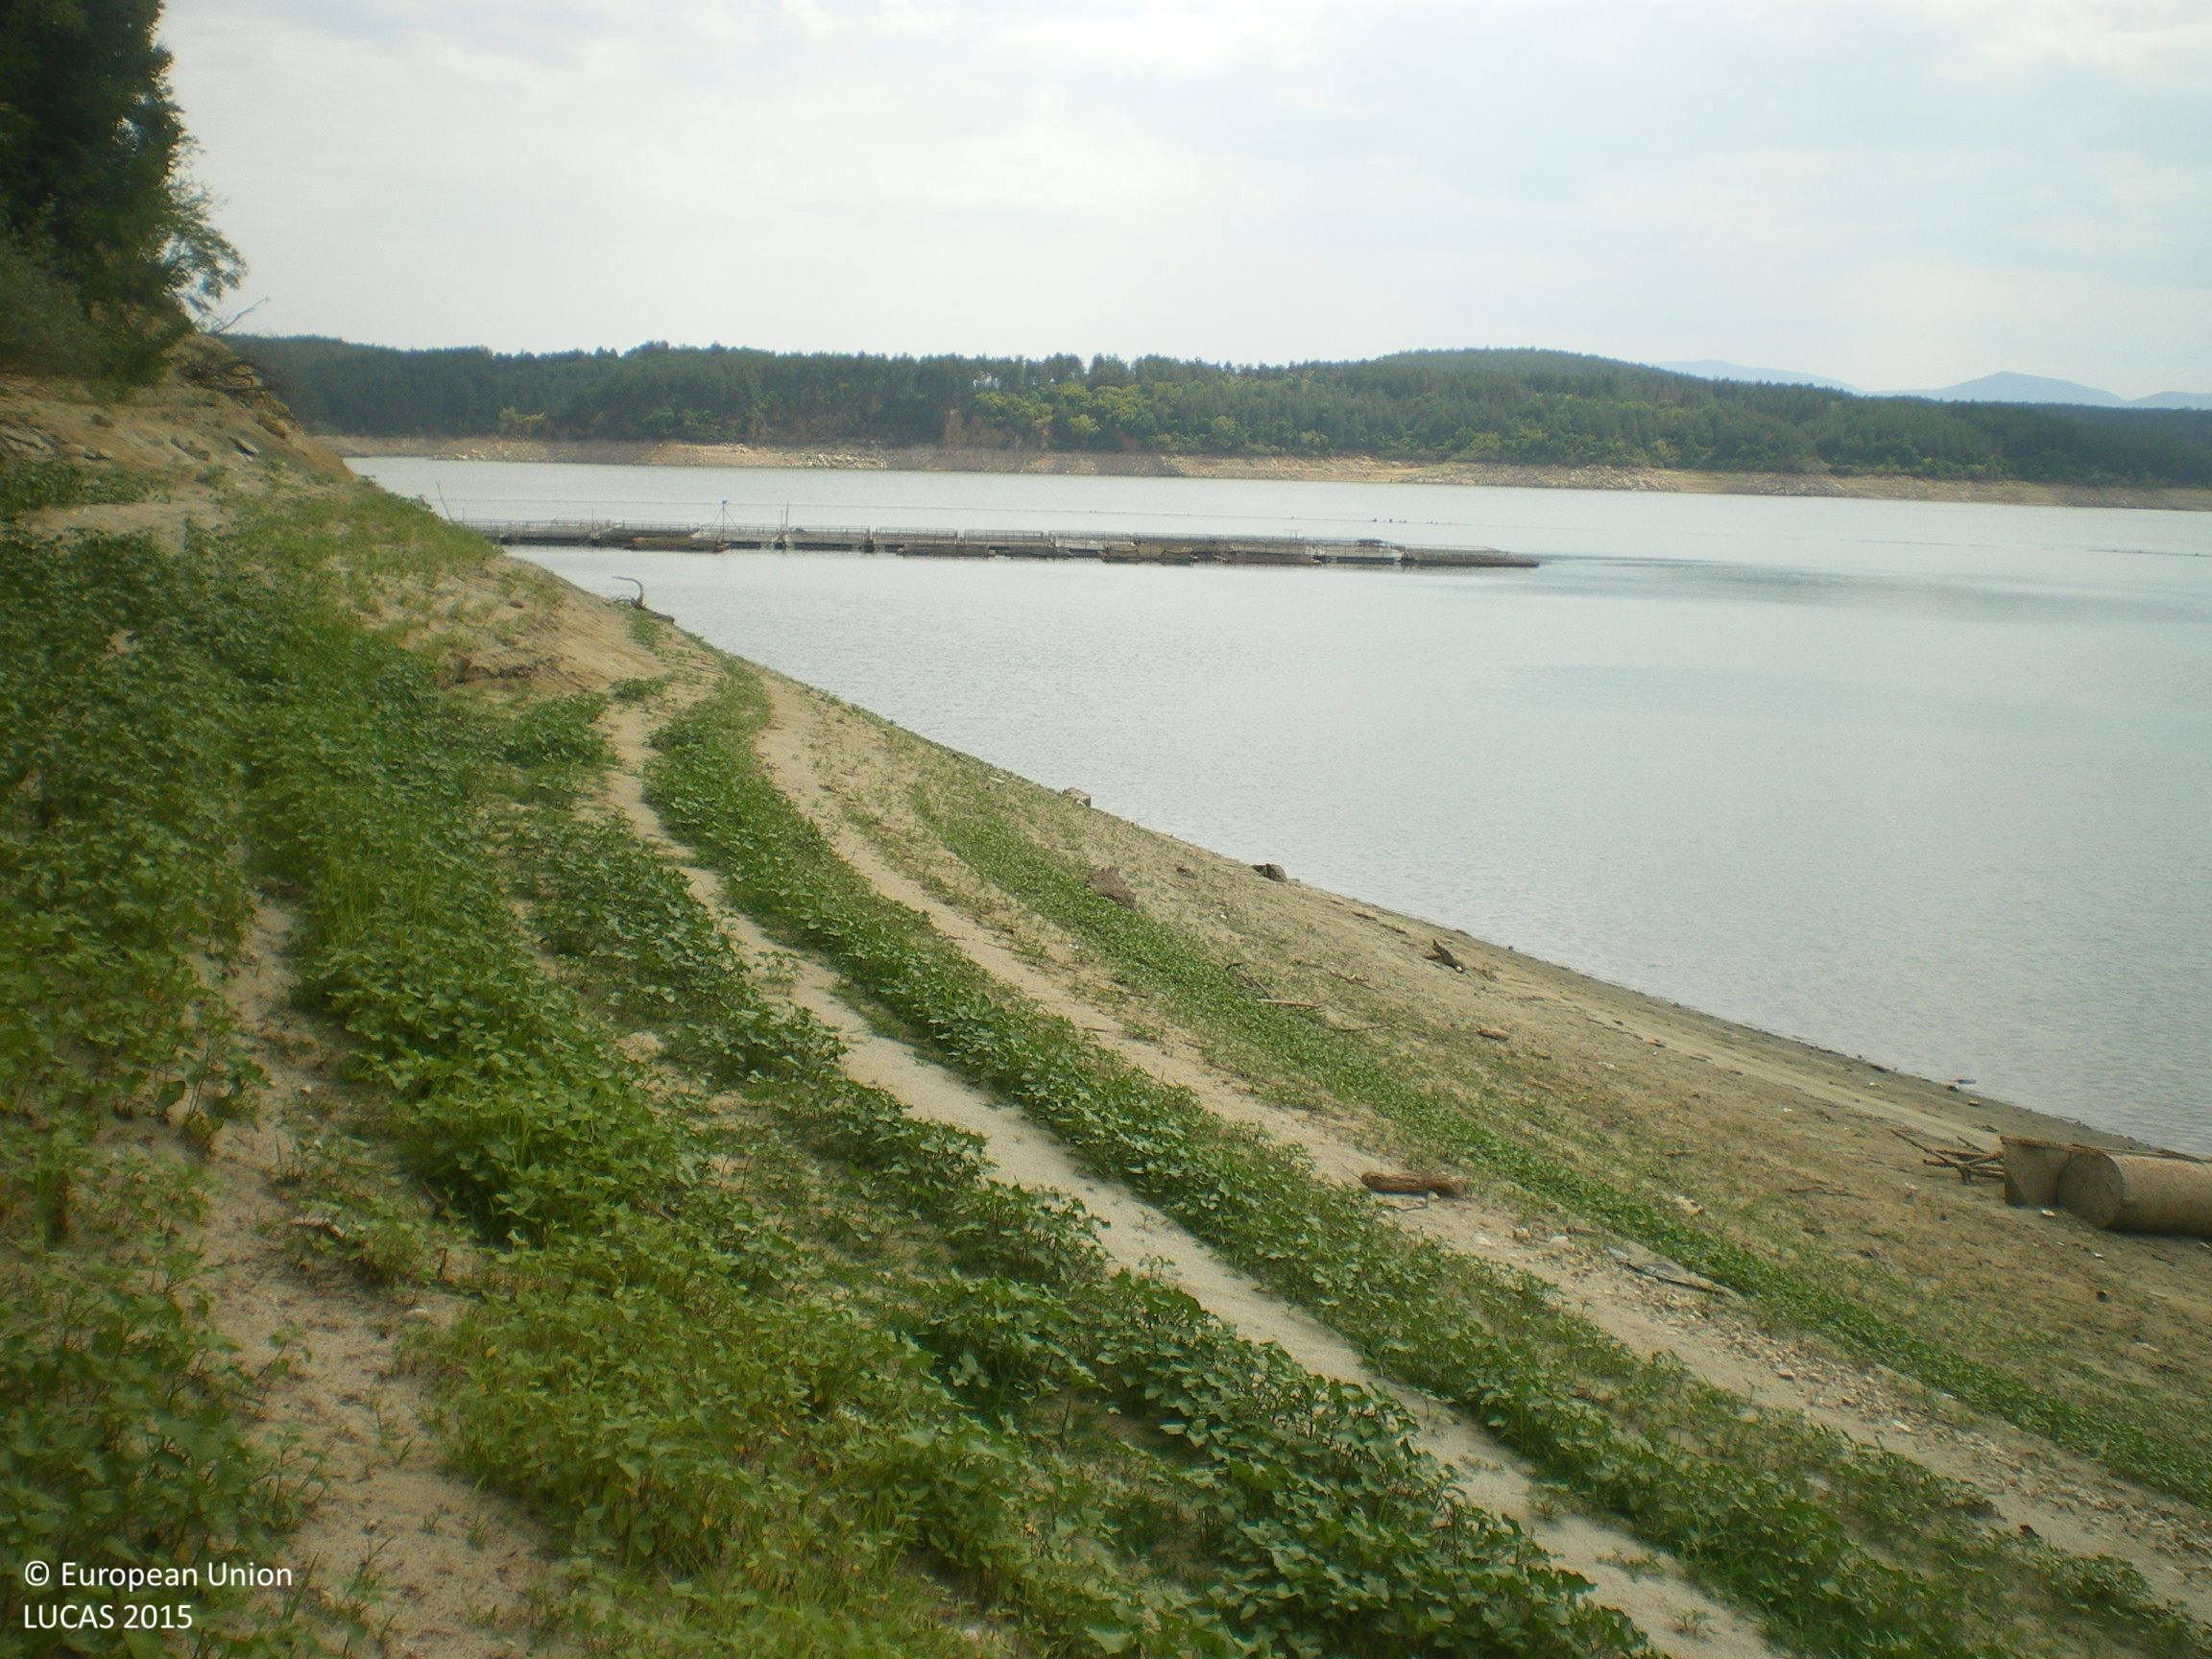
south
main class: Grassland
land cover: Spontaneously vegetated surfaces
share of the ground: > 75 %
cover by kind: herbaceous plants 60 %, unconsolidated bare surface 40 %
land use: Abandoned areas
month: August
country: BG
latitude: 42.6218
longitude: 25.2955
